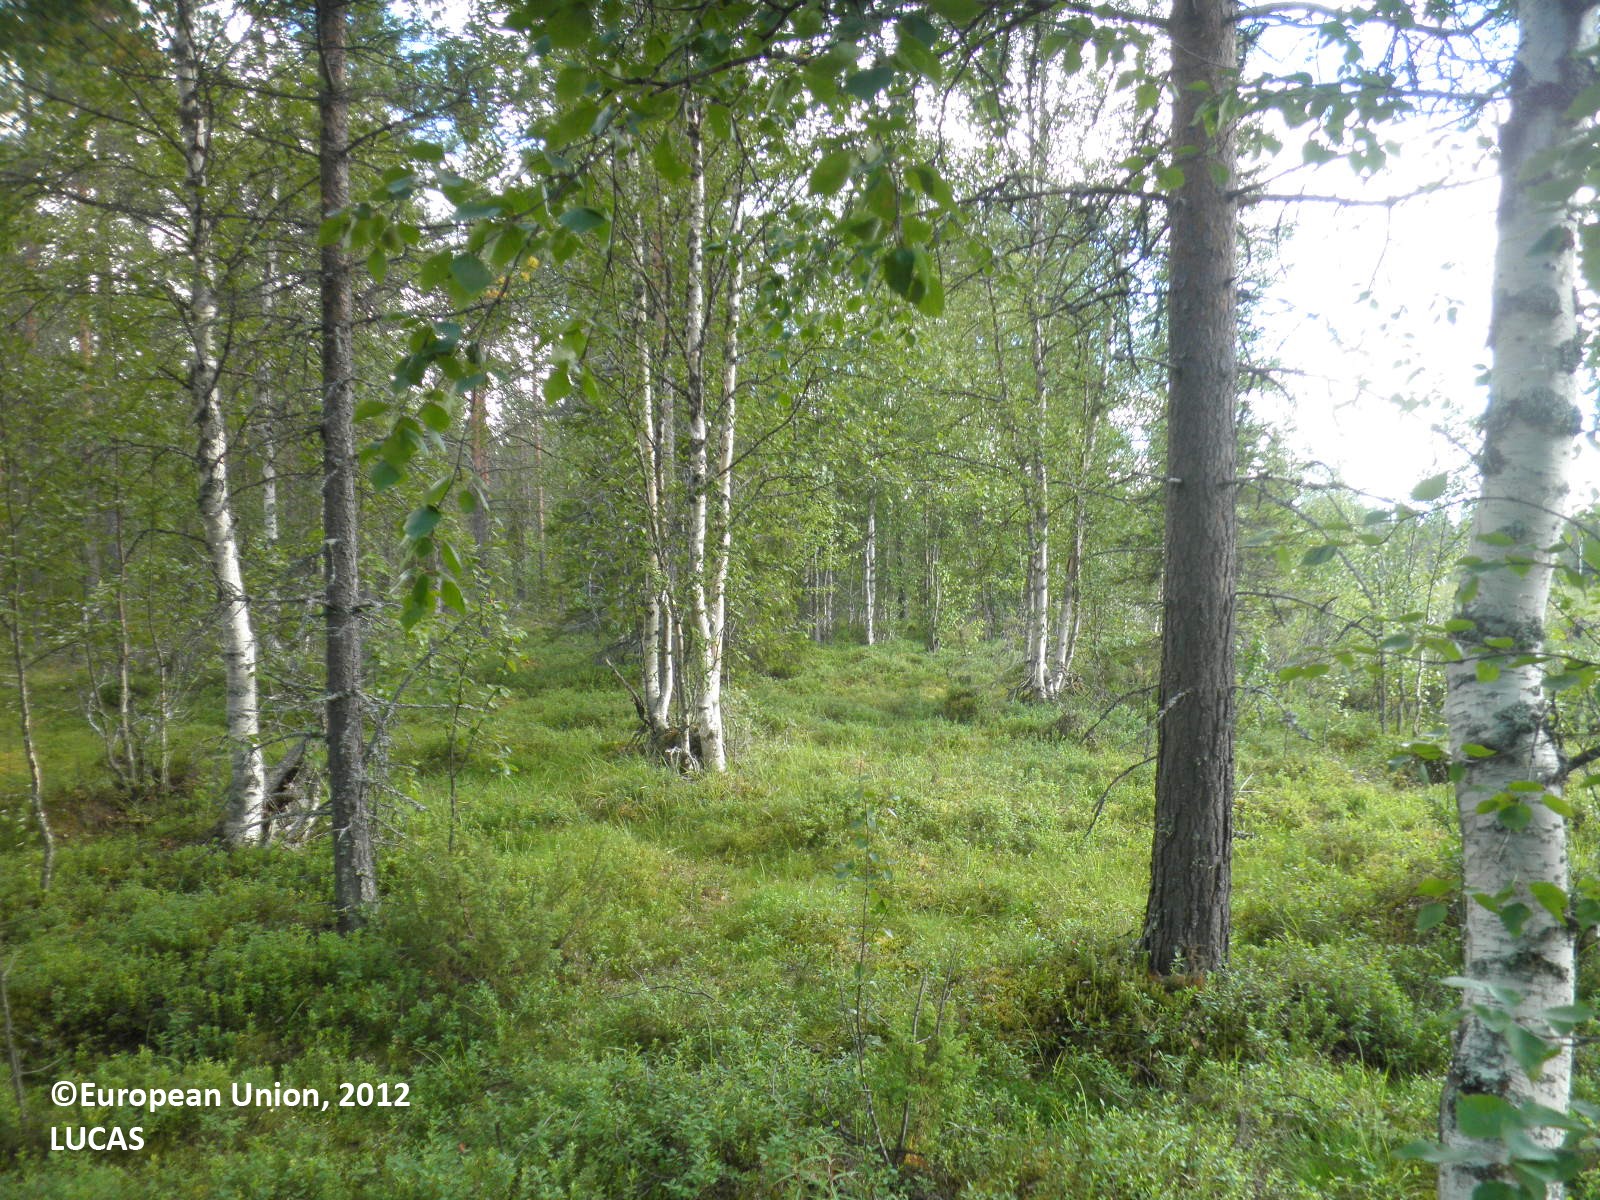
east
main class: Woodland
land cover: Pine dominated mixed woodland
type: boreal forest
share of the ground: 25 - 50 %
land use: Forestry
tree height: > 5 m
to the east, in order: Pine dominated mixed woodland; Tracks; Pine dominated mixed woodland; Pine dominated coniferous woodland
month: August
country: FI
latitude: 67.3968
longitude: 27.7566
